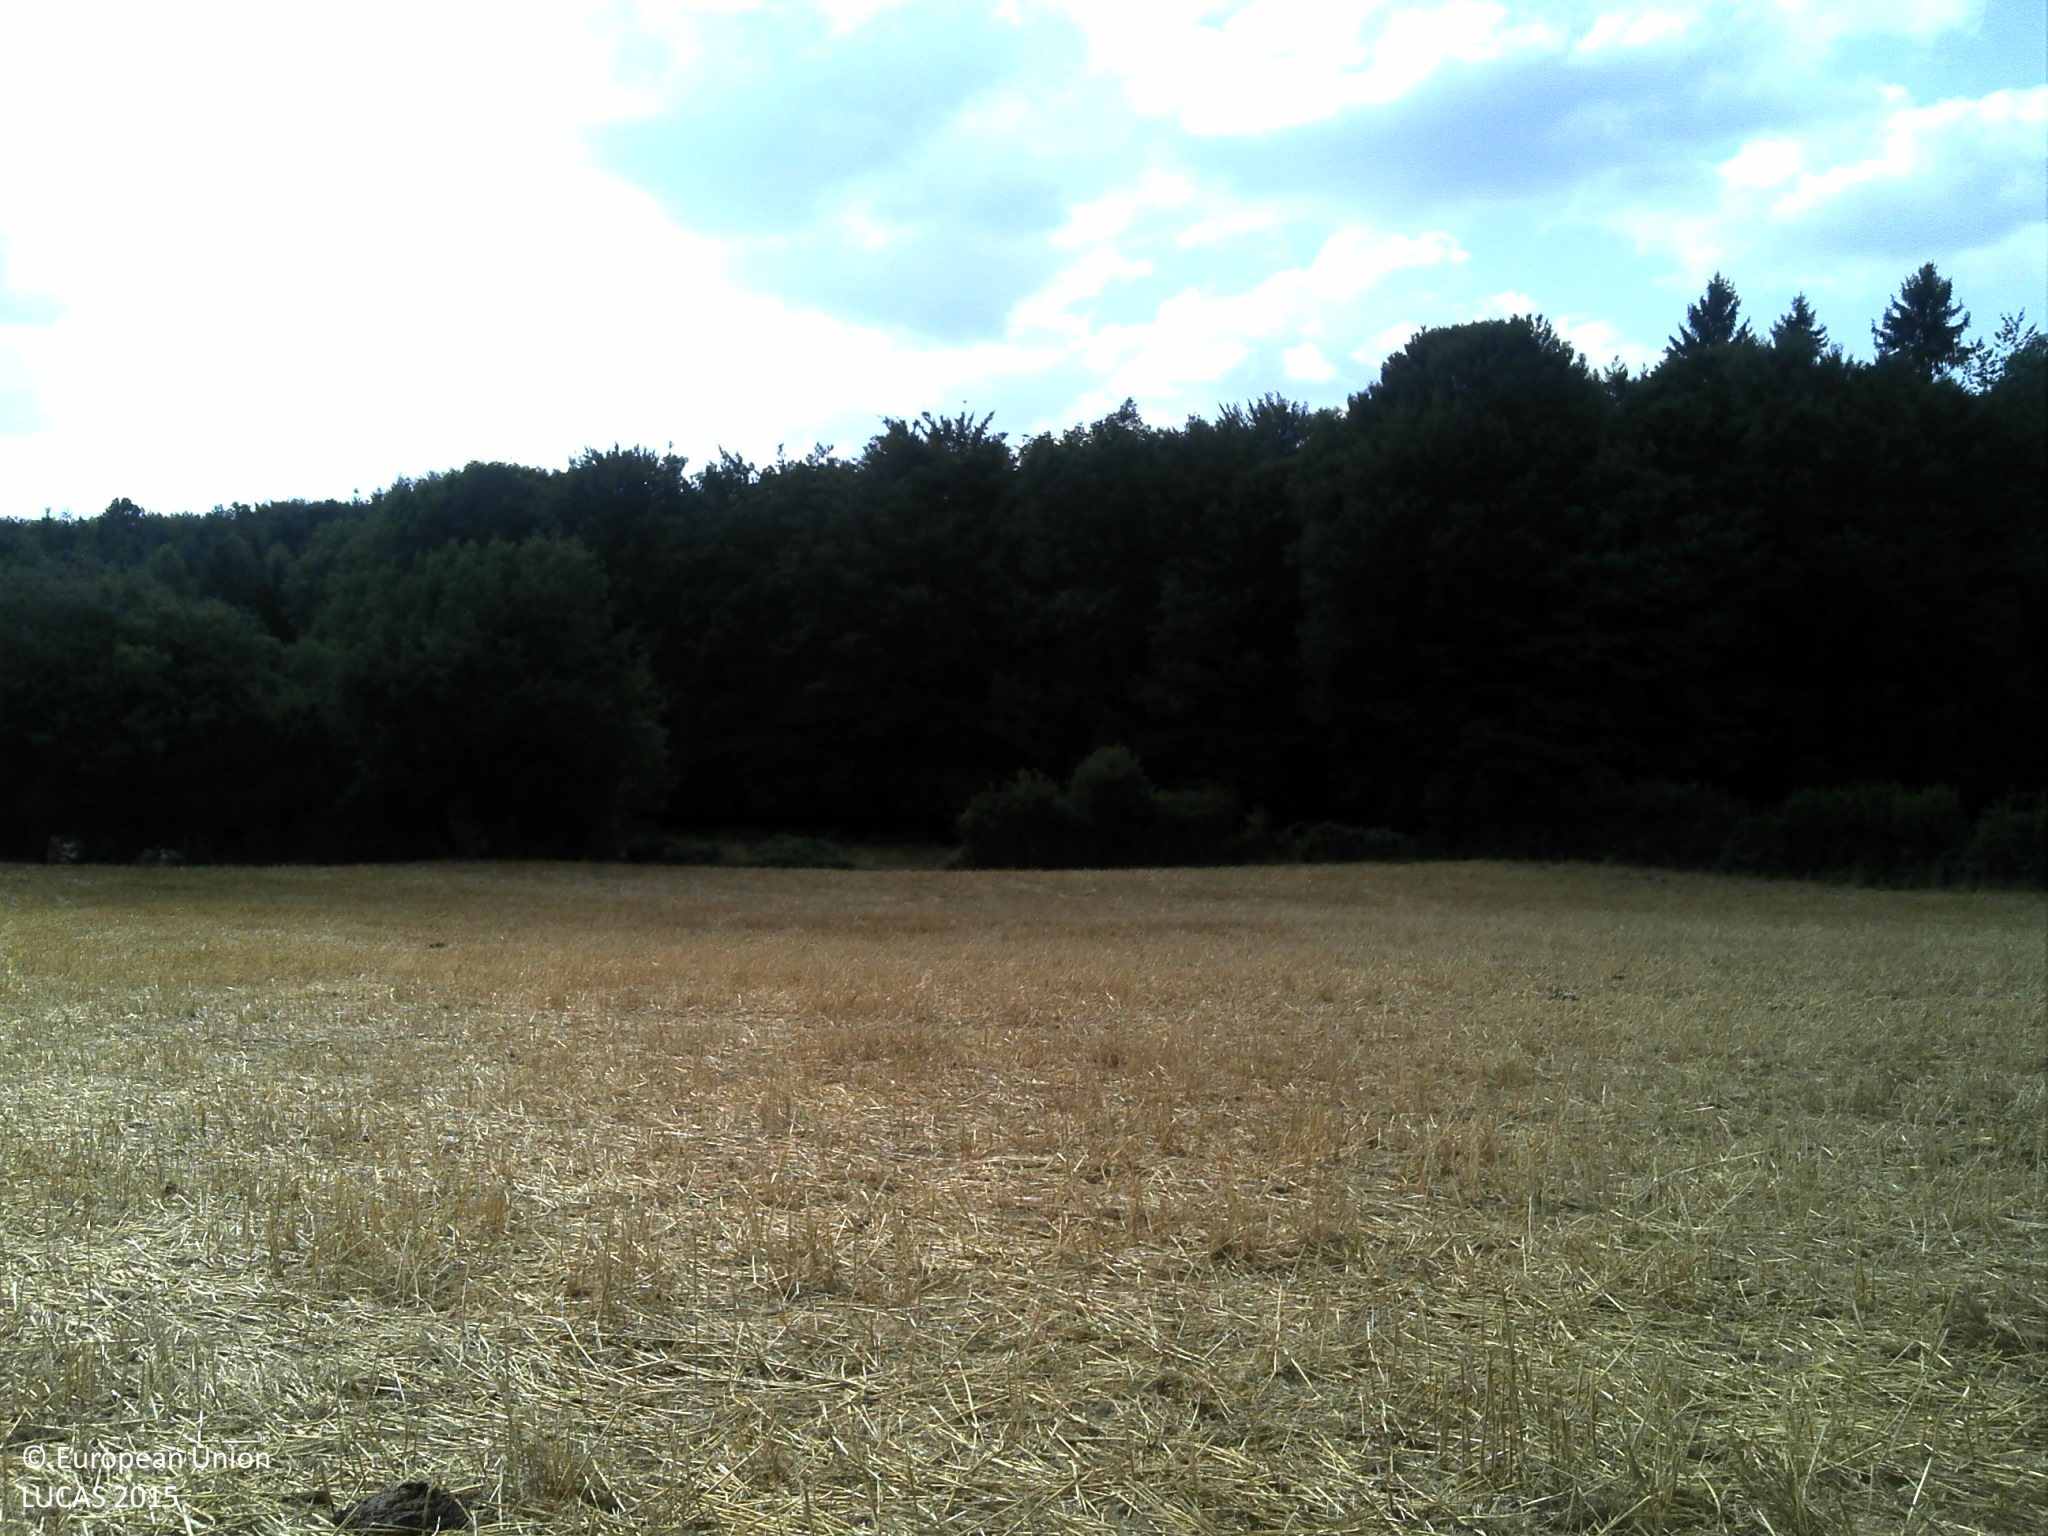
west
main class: Cropland
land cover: Common wheat
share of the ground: > 75 %
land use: Agriculture (excluding fallow land and kitchen gardens)
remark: Harvested field
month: August
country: FR
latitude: 45.5202
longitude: 2.4063
